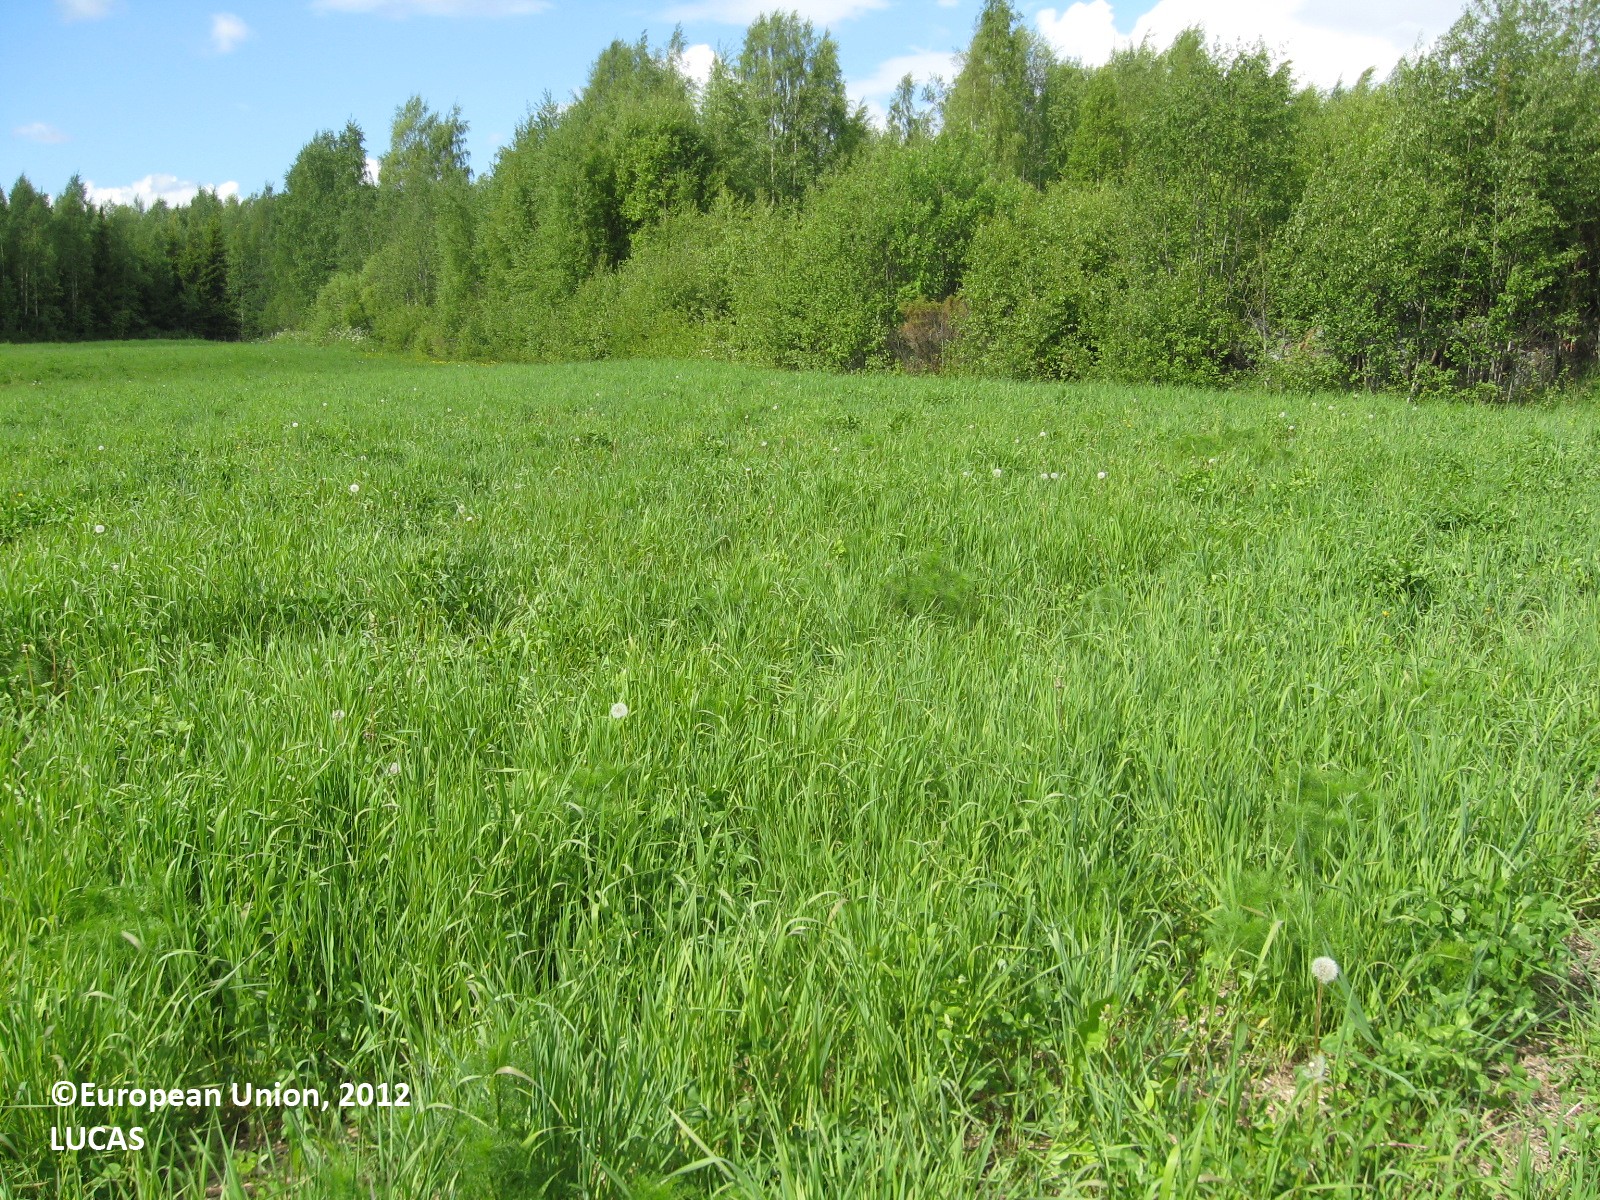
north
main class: Grassland
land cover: Grassland without tree/shrub cover
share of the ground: > 75 %
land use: Agriculture (excluding fallow land and kitchen gardens)
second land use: Energy production
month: June
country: FI
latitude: 63.0709
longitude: 21.8986
